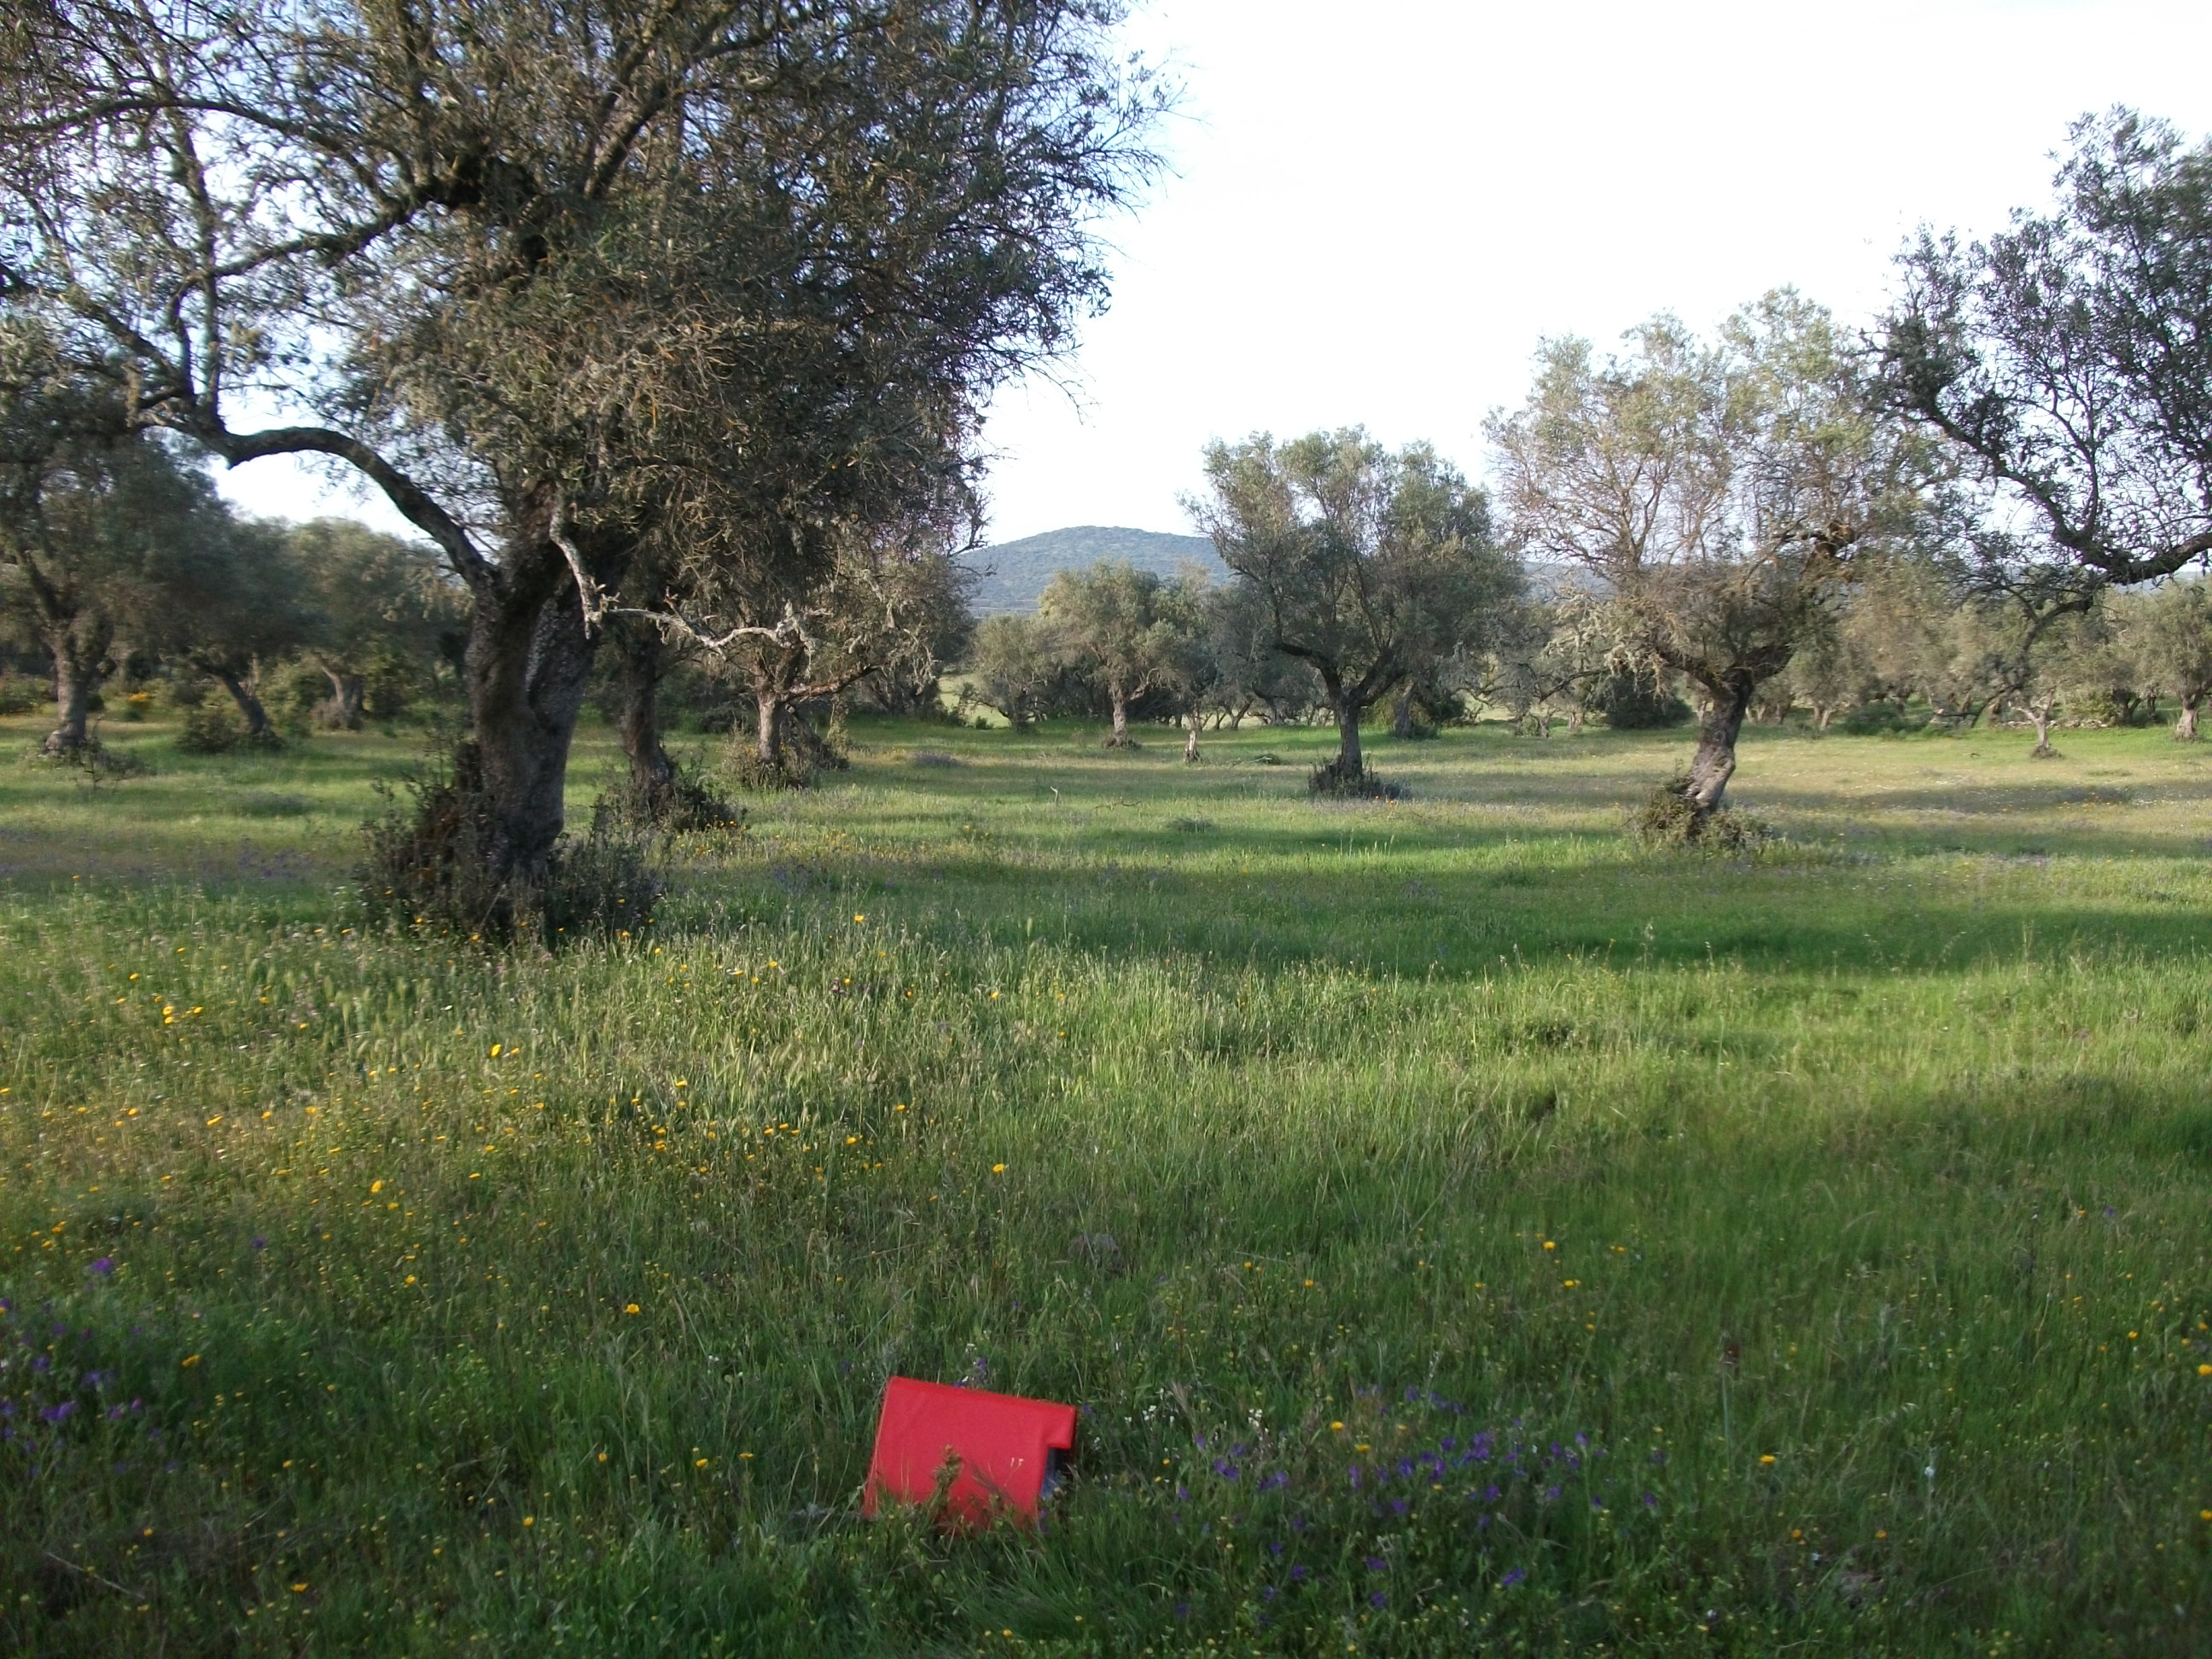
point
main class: Cropland
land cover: Olive groves
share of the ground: 25 - 50 %
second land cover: Spontaneously vegetated surfaces
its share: > 75 %
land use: Agriculture (excluding fallow land and kitchen gardens)
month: April
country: ES
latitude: 38.0798
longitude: -6.6358
